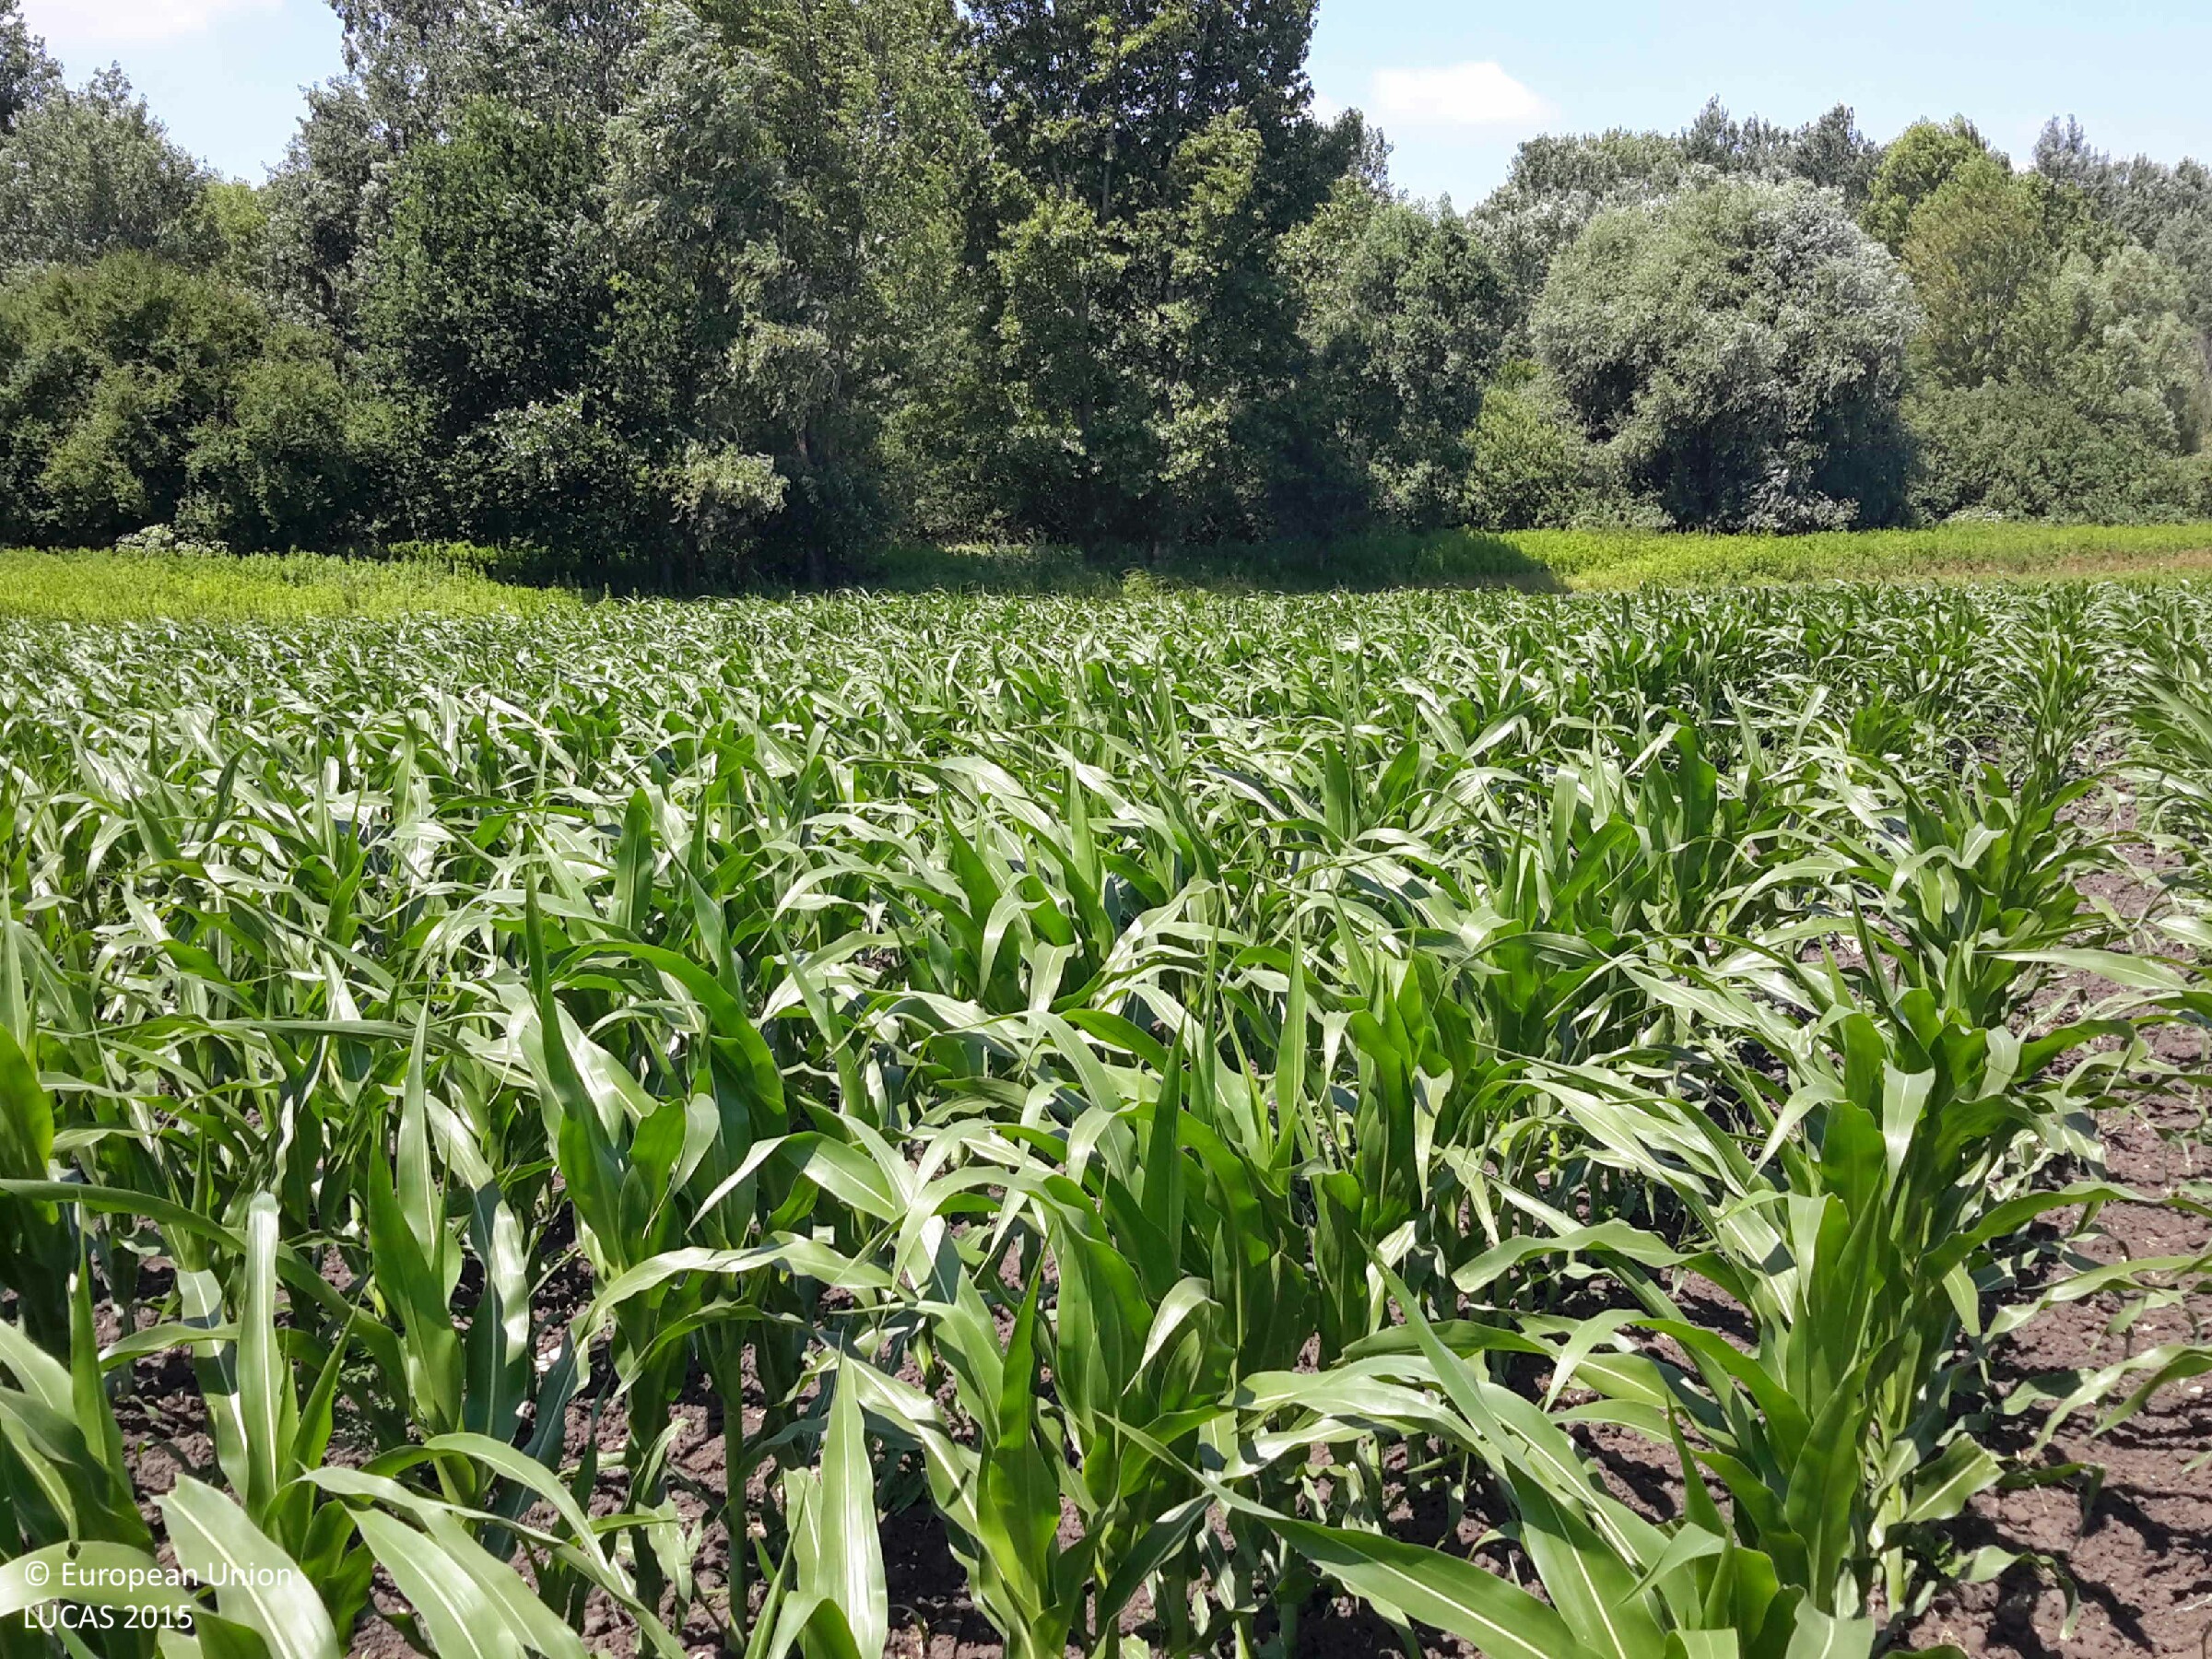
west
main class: Cropland
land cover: Maize
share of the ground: > 75 %
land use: Agriculture (excluding fallow land and kitchen gardens)
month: June
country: HU
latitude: 47.6836
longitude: 17.4283
